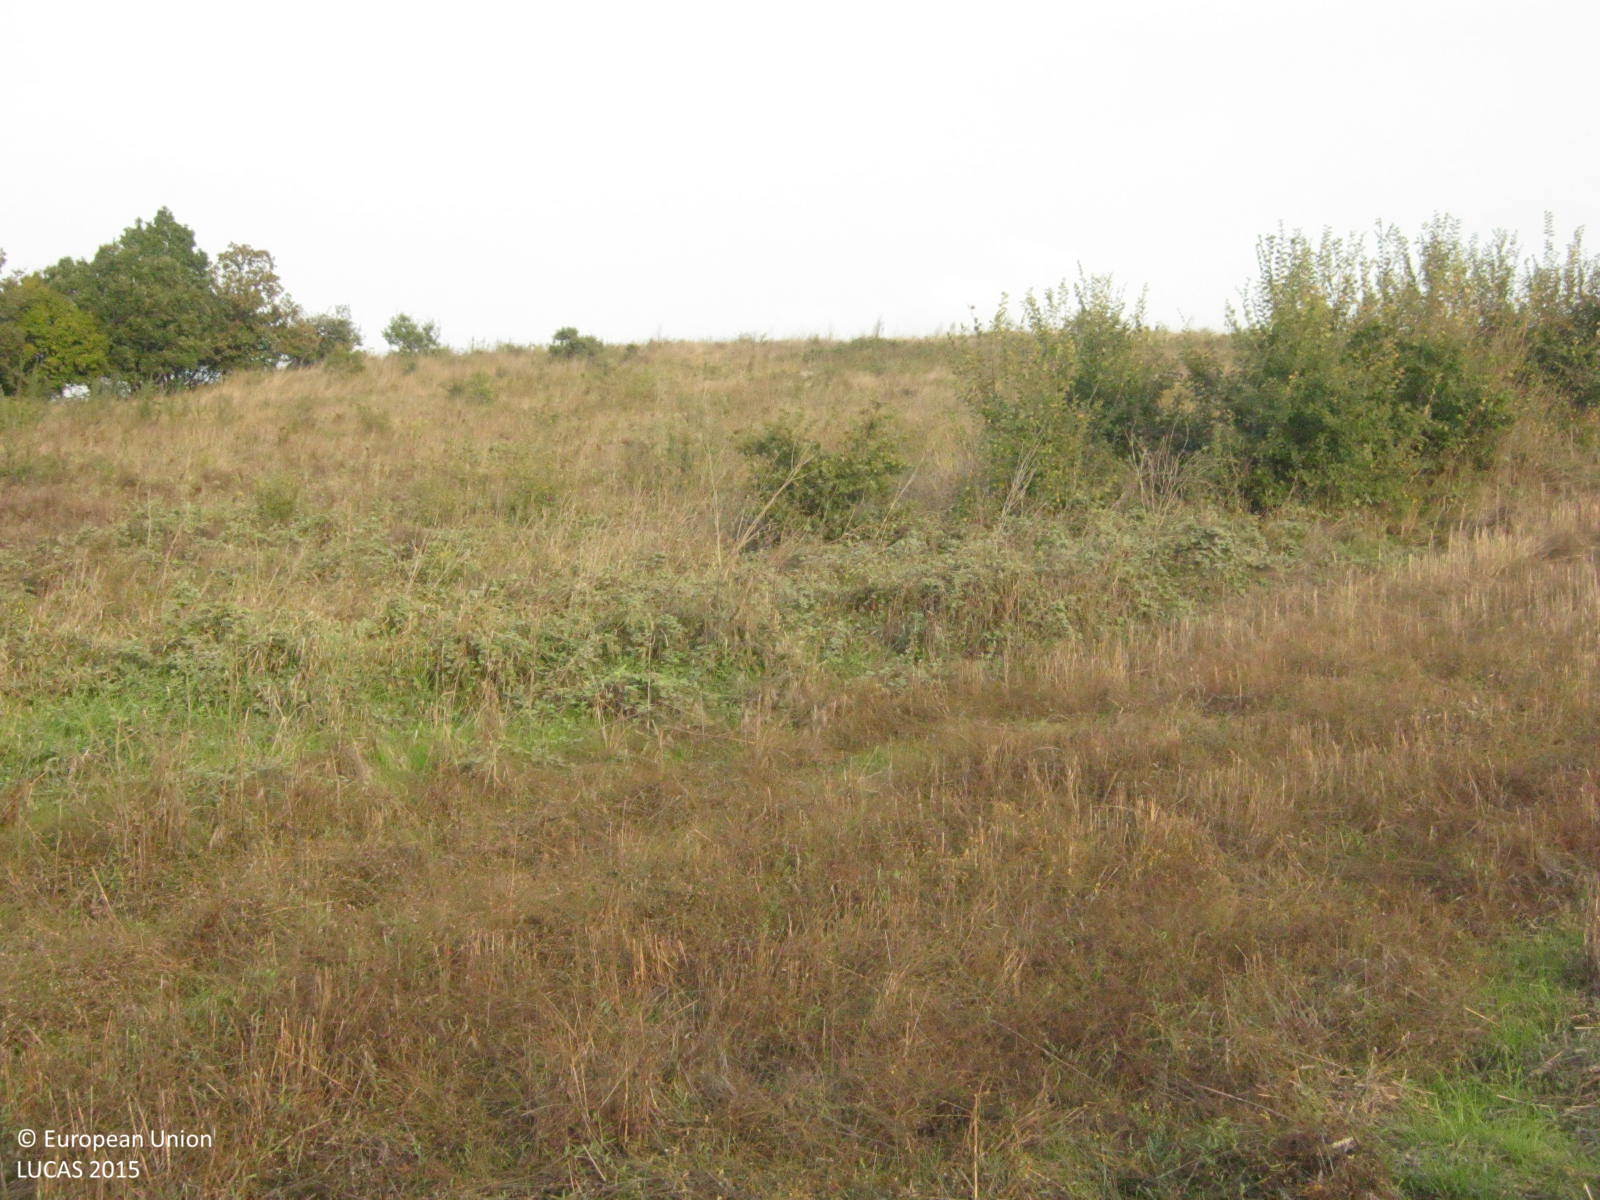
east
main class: Woodland
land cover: Broadleaved woodland
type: thermophilous deciduous forest
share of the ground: > 75 %
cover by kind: broadleaved forest trees 75 %, shrubs 15 %, herbaceous plants 10 %
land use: Semi-natural and natural areas not in use
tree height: > 5 m
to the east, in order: Broadleaved woodland; Spontaneously vegetated surfaces; Shrubland with sparse tree cover; Common wheat; Spontaneously vegetated surfaces; Abandoned hedges; Spontaneously vegetated surfaces; Shrubland with sparse tree cover; Spontaneously vegetated surfaces
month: October
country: GR
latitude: 40.9746
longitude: 22.9768
